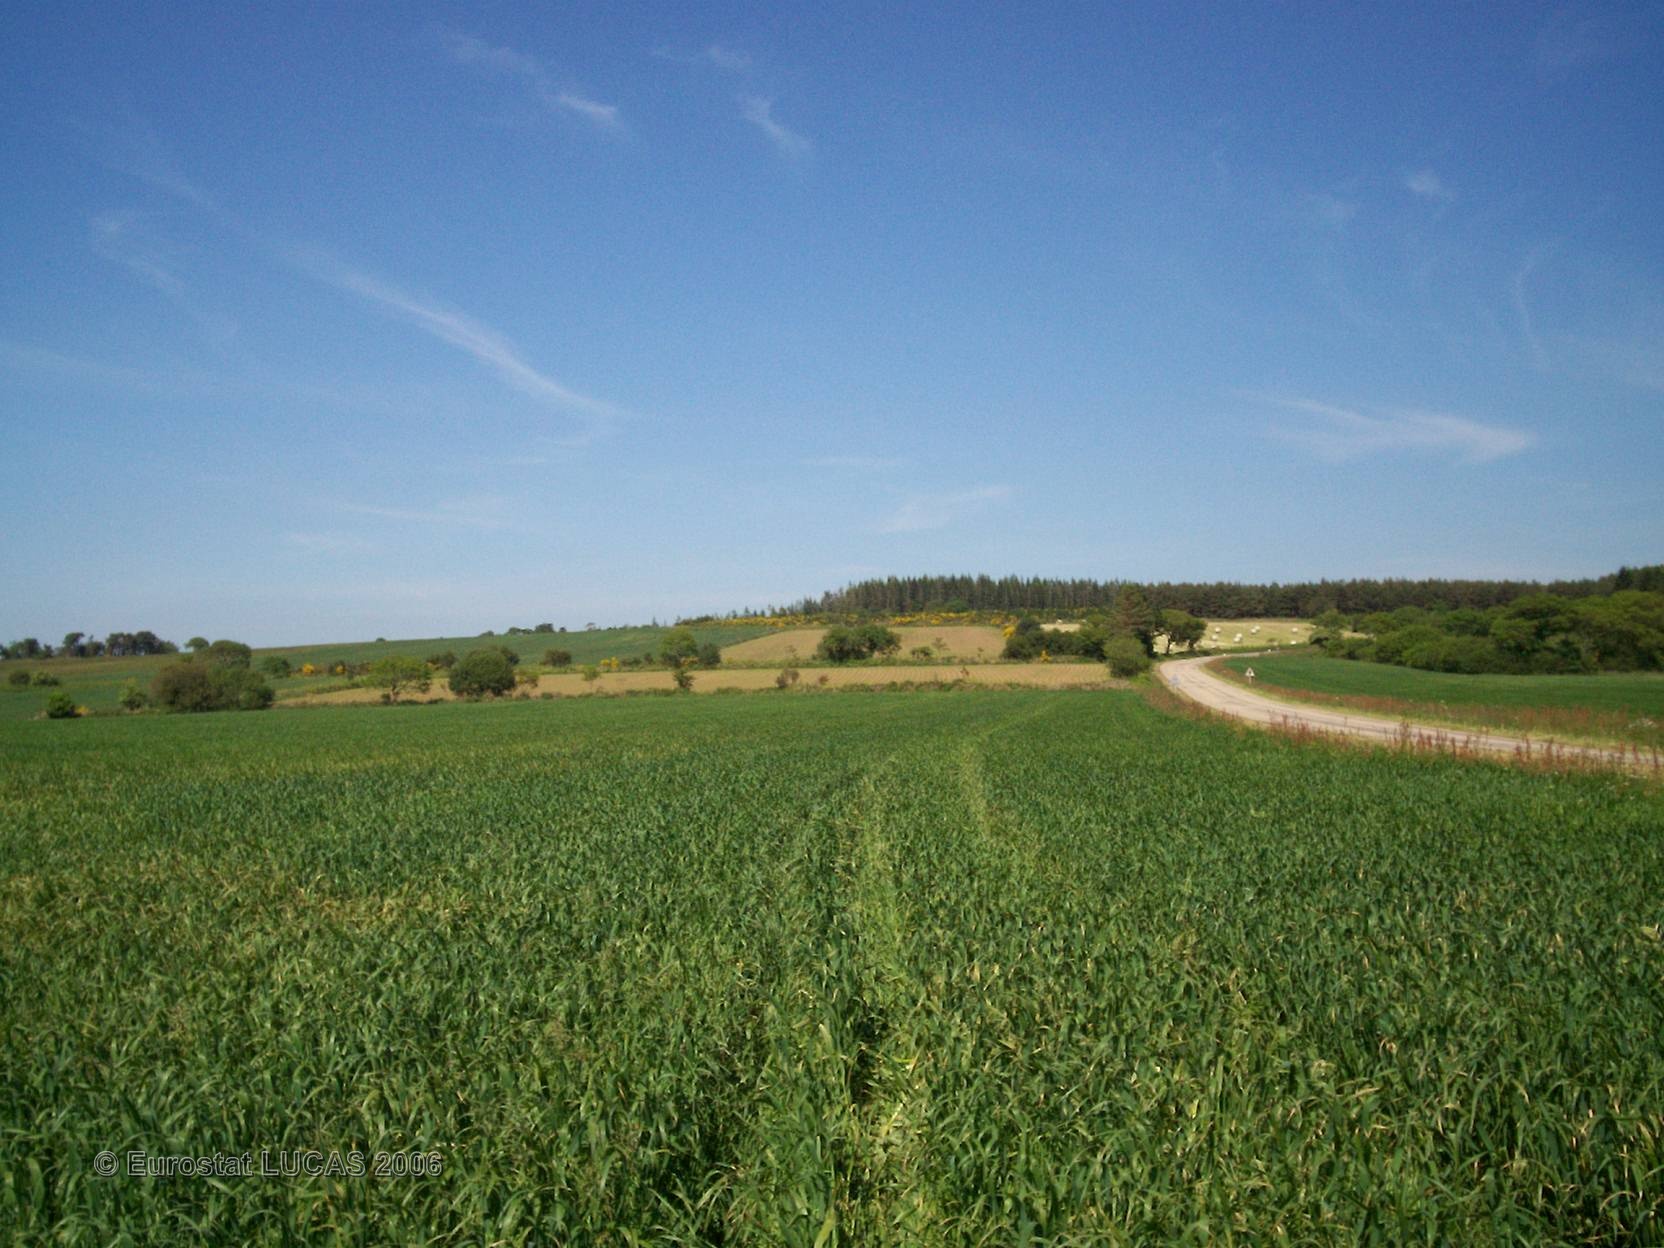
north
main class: Grassland
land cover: Grassland without tree/shrub cover
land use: Agriculture (excluding fallow land and kitchen gardens)
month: June
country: FR
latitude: 48.4648
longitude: -3.6465
